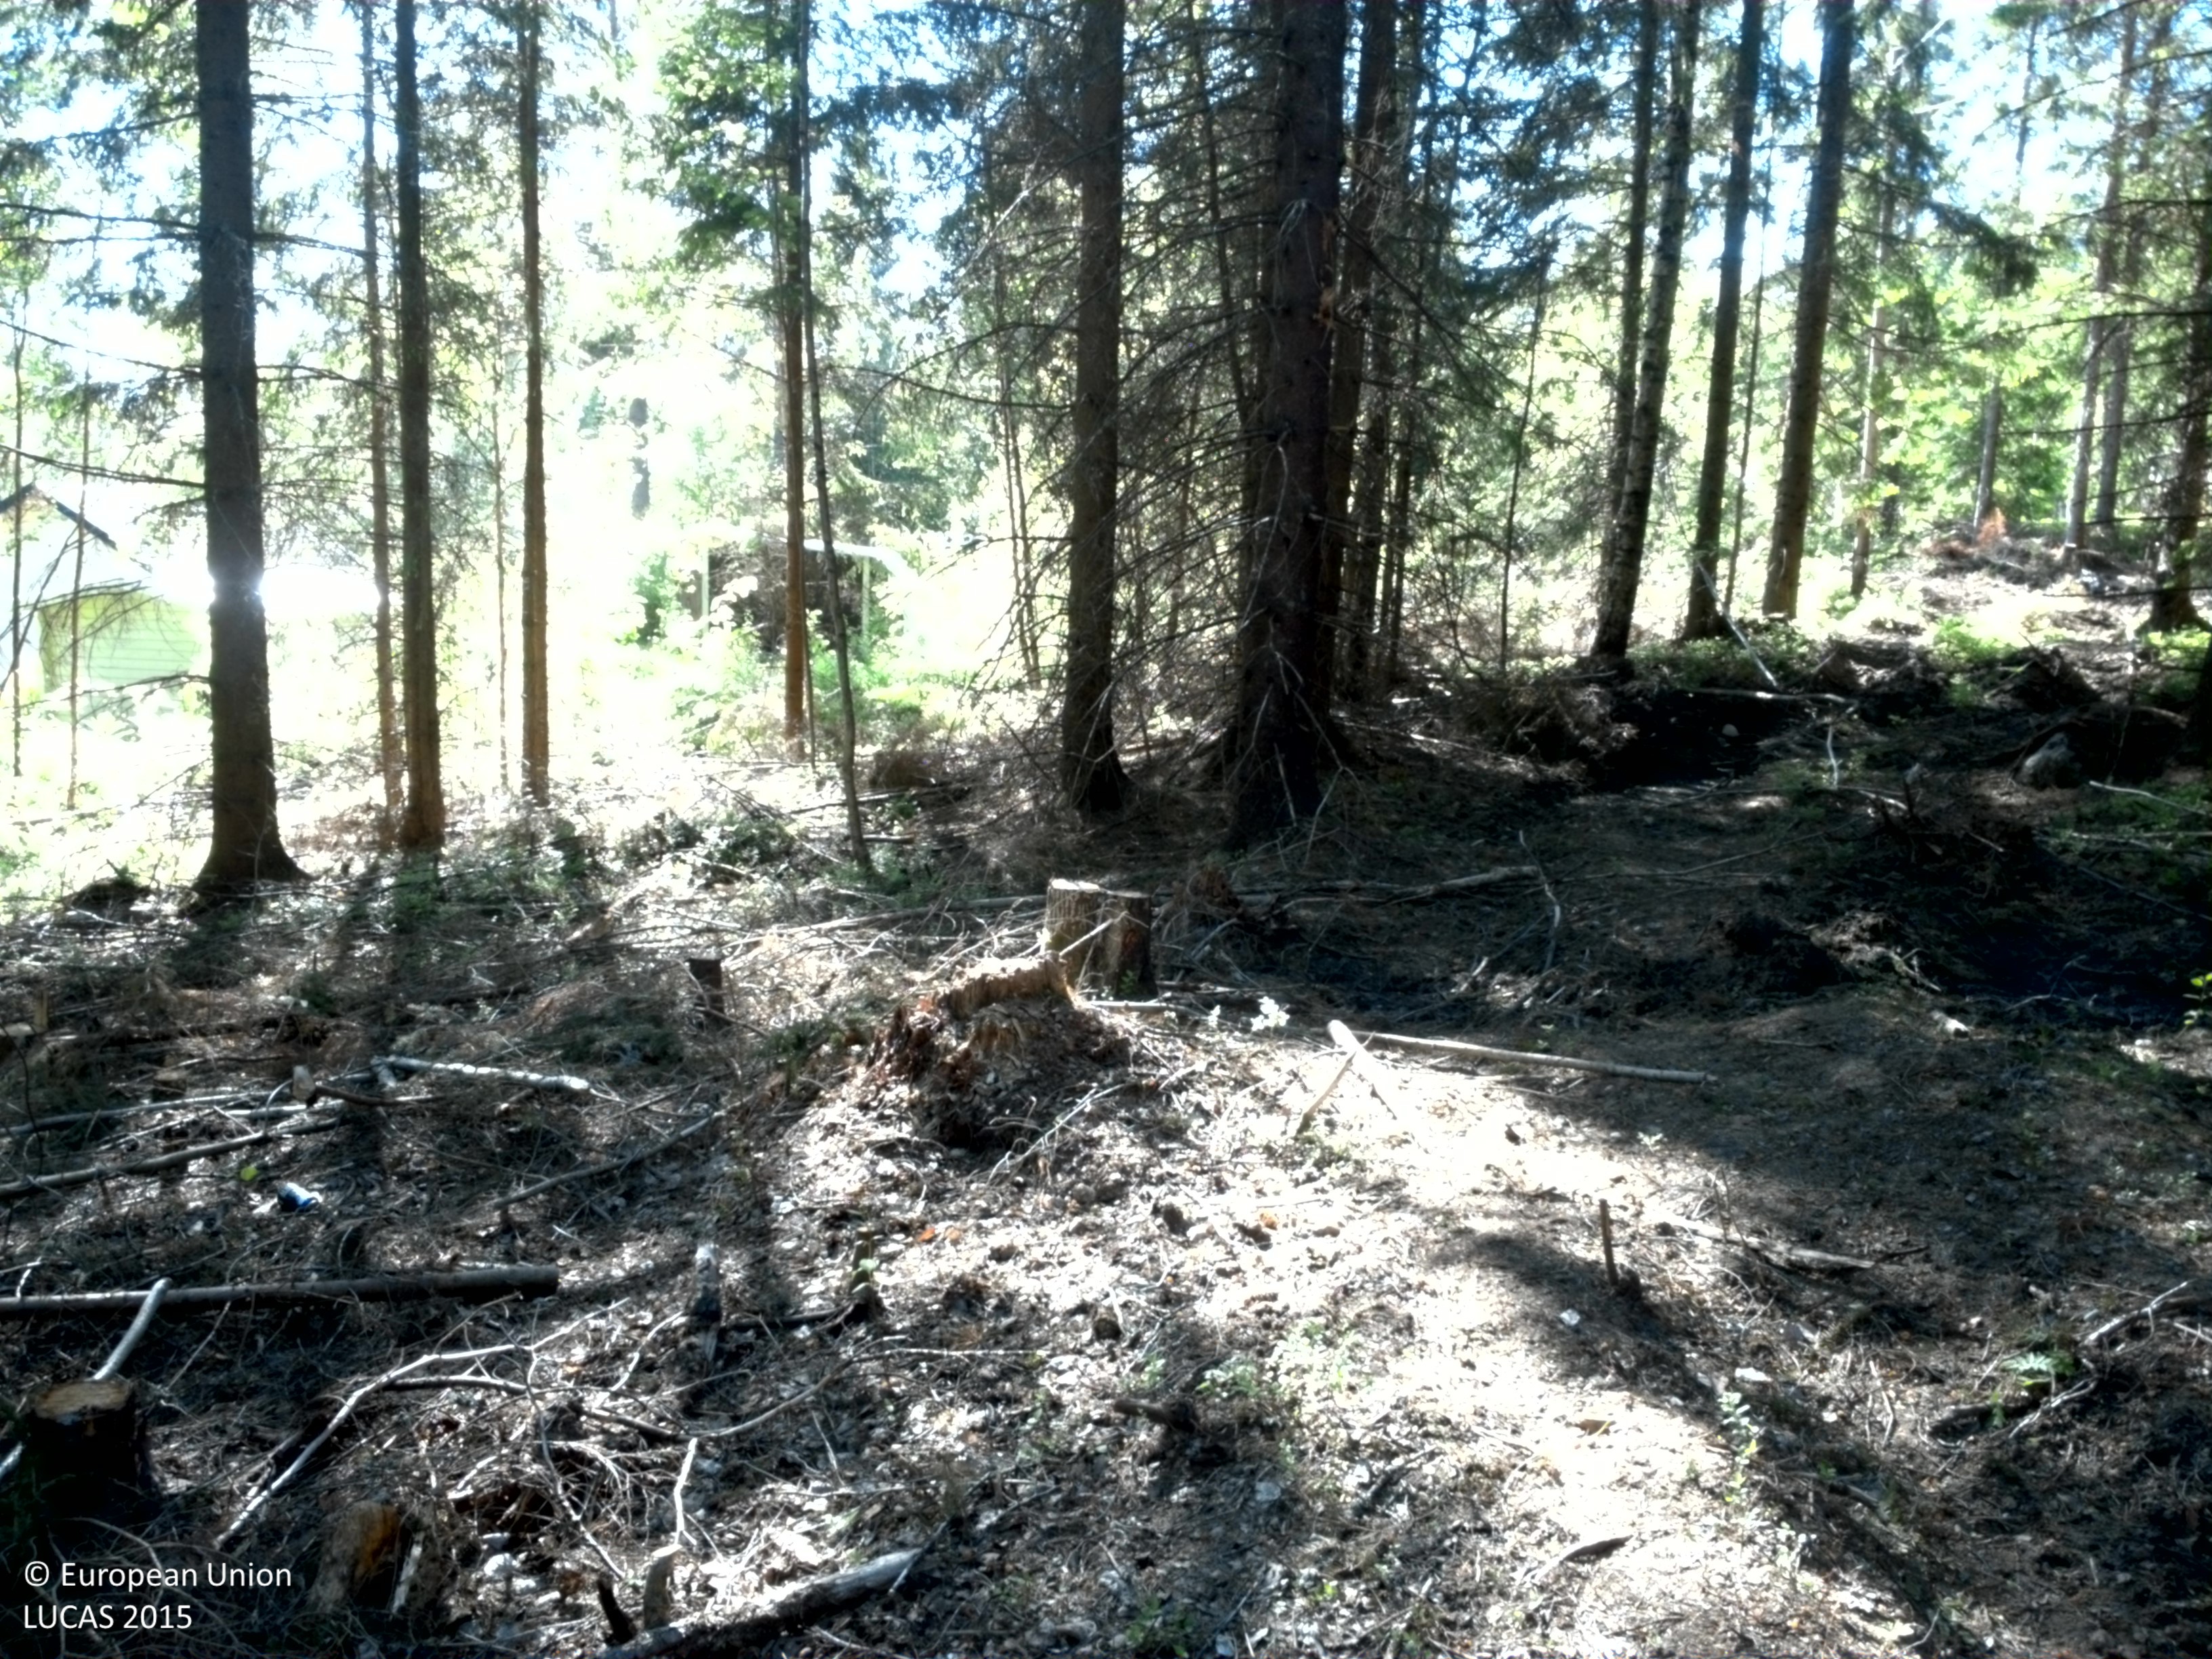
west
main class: Woodland
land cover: Spruce dominated mixed woodland
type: boreal forest
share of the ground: 50 - 75 %
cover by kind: coniferous forest trees 35 %, broadleaved forest trees 25 %, unconsolidated bare surface 15 %, shrubs 10 %, herbaceous plants 5 %
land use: Forestry
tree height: > 5 m
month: June
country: SE
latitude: 59.2928
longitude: 14.6440
